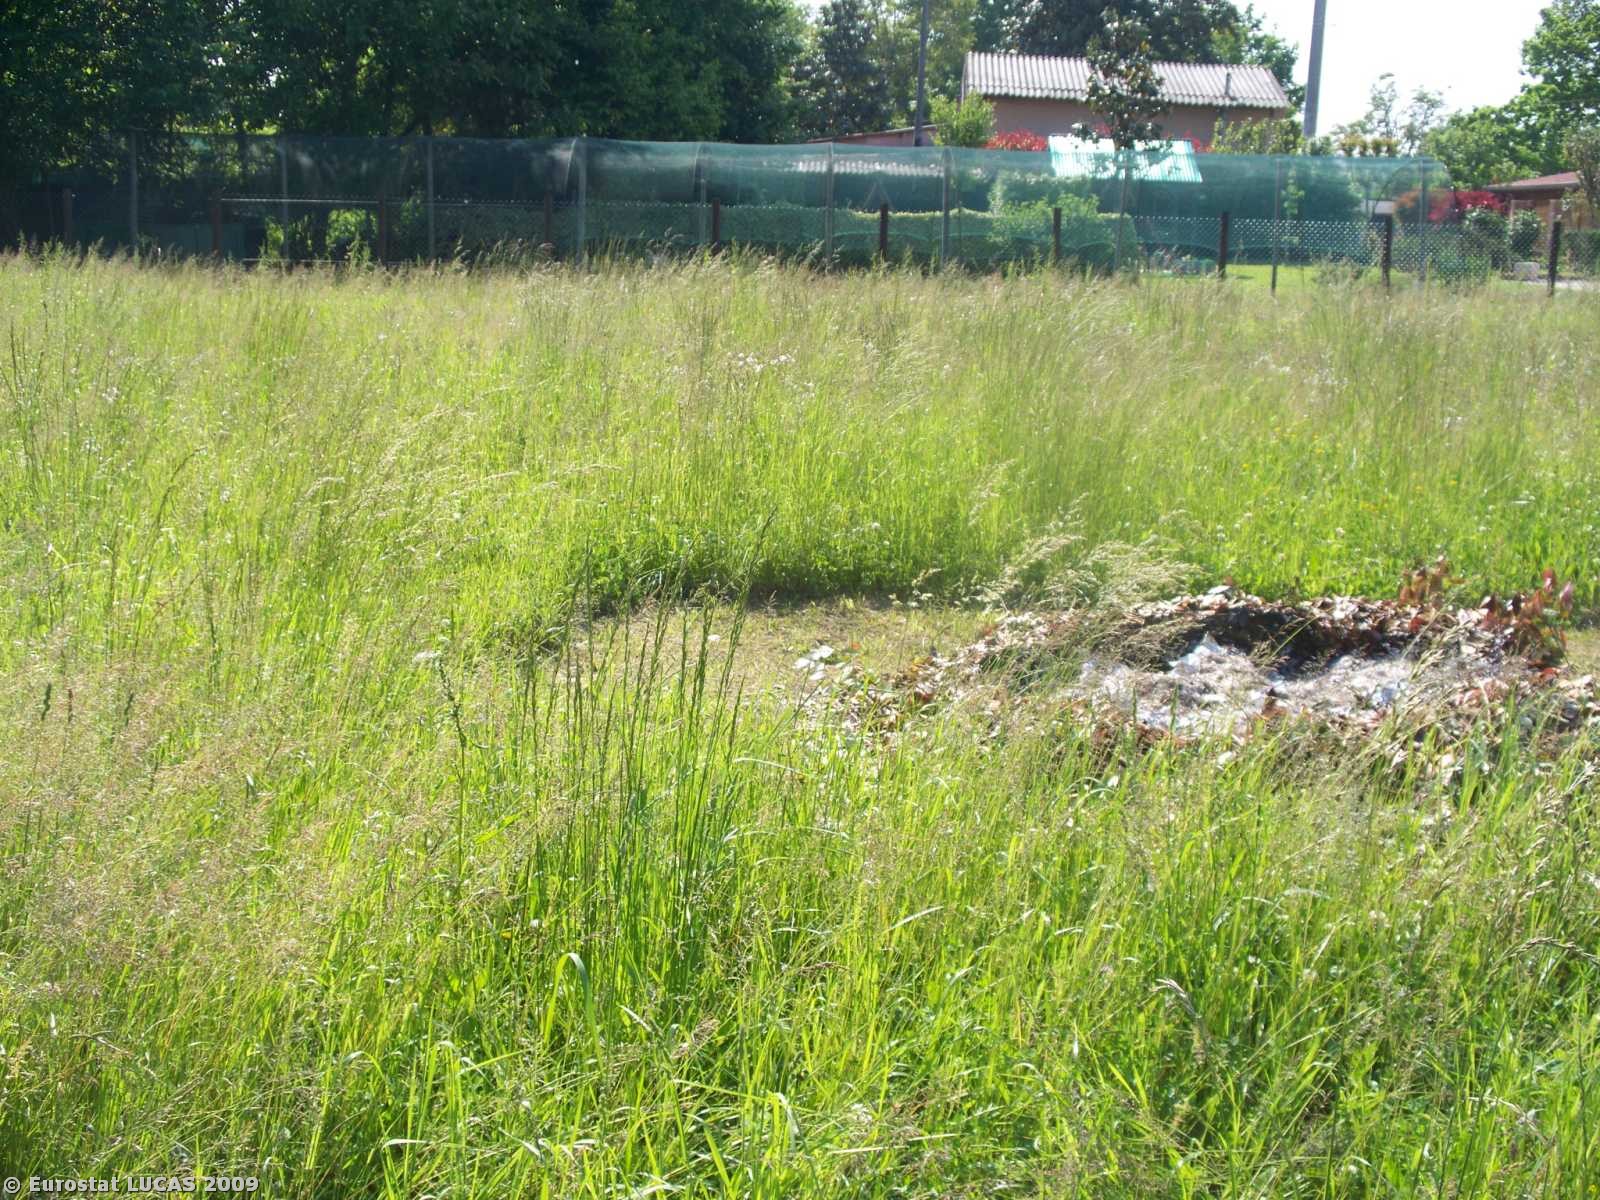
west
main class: Cropland
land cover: Vineyards
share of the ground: < 10 %
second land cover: Grassland with sparse tree/shrub cover
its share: > 75 %
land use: Agriculture (excluding fallow land and kitchen gardens)
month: May
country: IT
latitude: 45.5384
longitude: 12.0586
